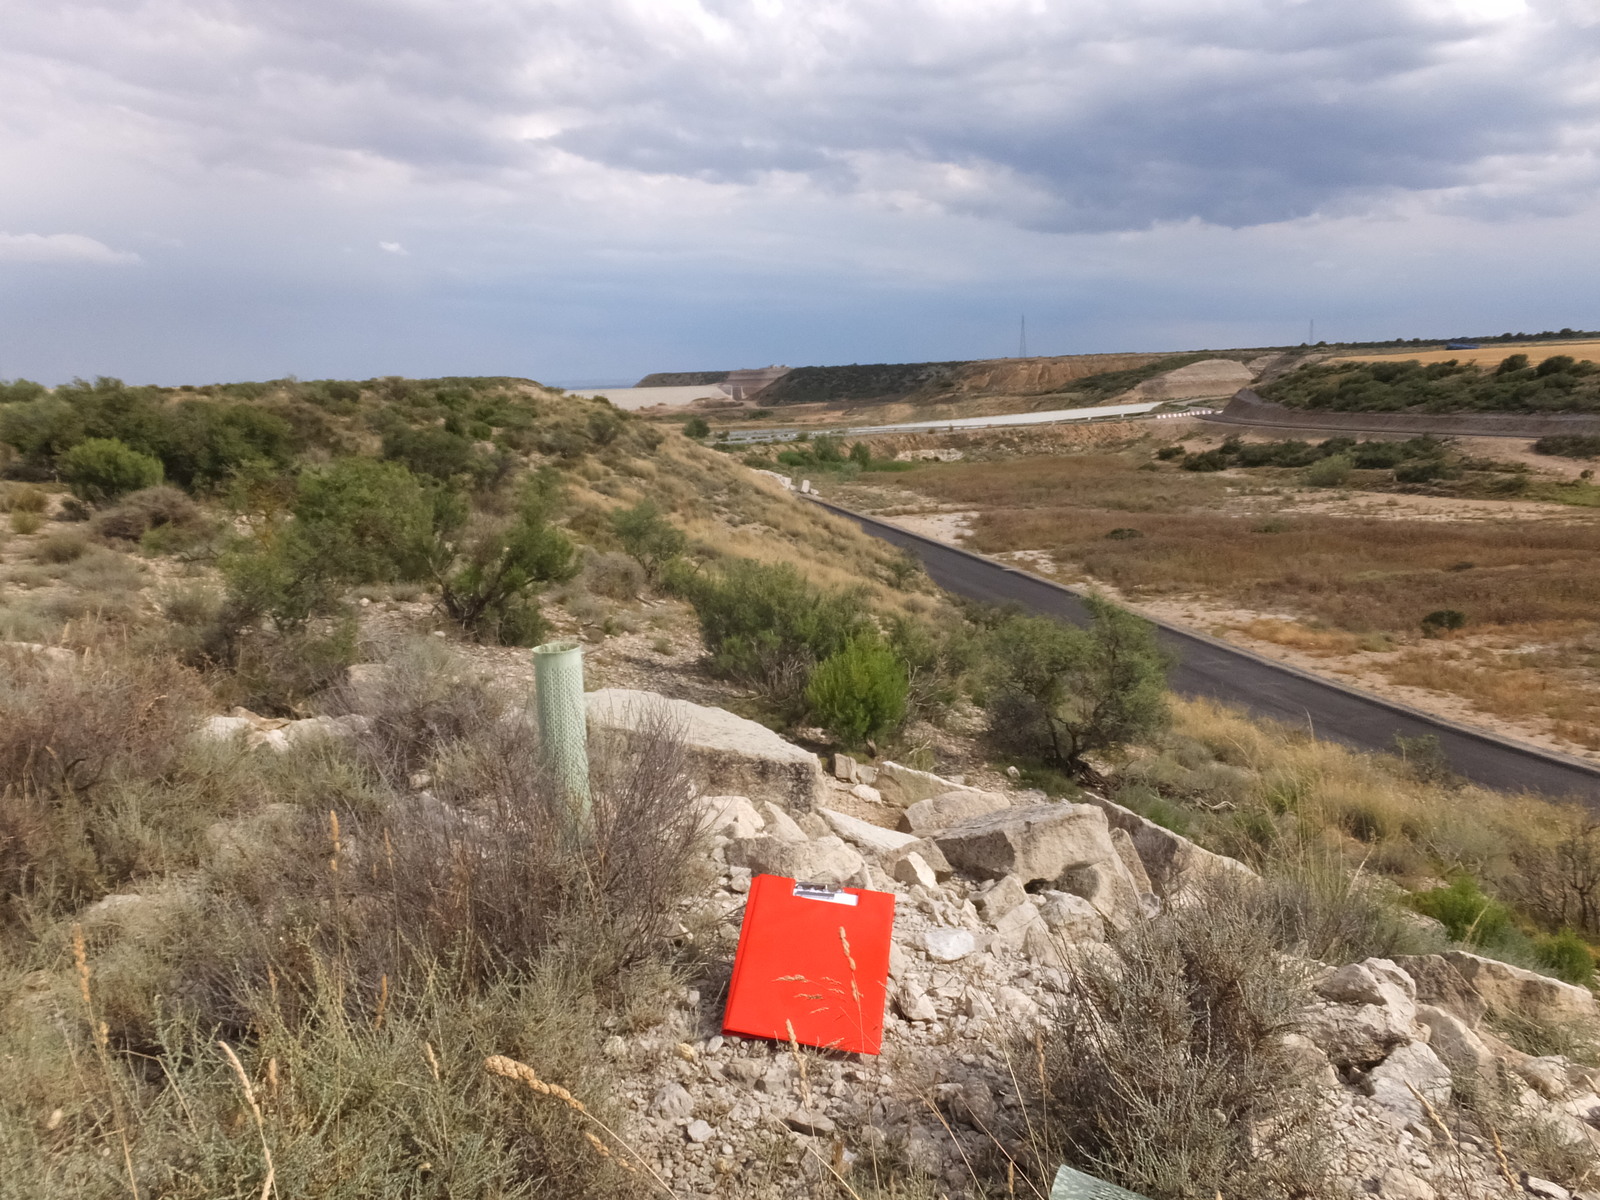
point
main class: Shrubland
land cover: Shrubland with sparse tree cover
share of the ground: 50 - 75 %
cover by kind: shrubs 60 %, herbaceous plants 35 %, coniferous forest trees 5 %
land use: Semi-natural and natural areas not in use
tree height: < 5 m
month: June
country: ES
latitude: 41.5622
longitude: 0.0447
